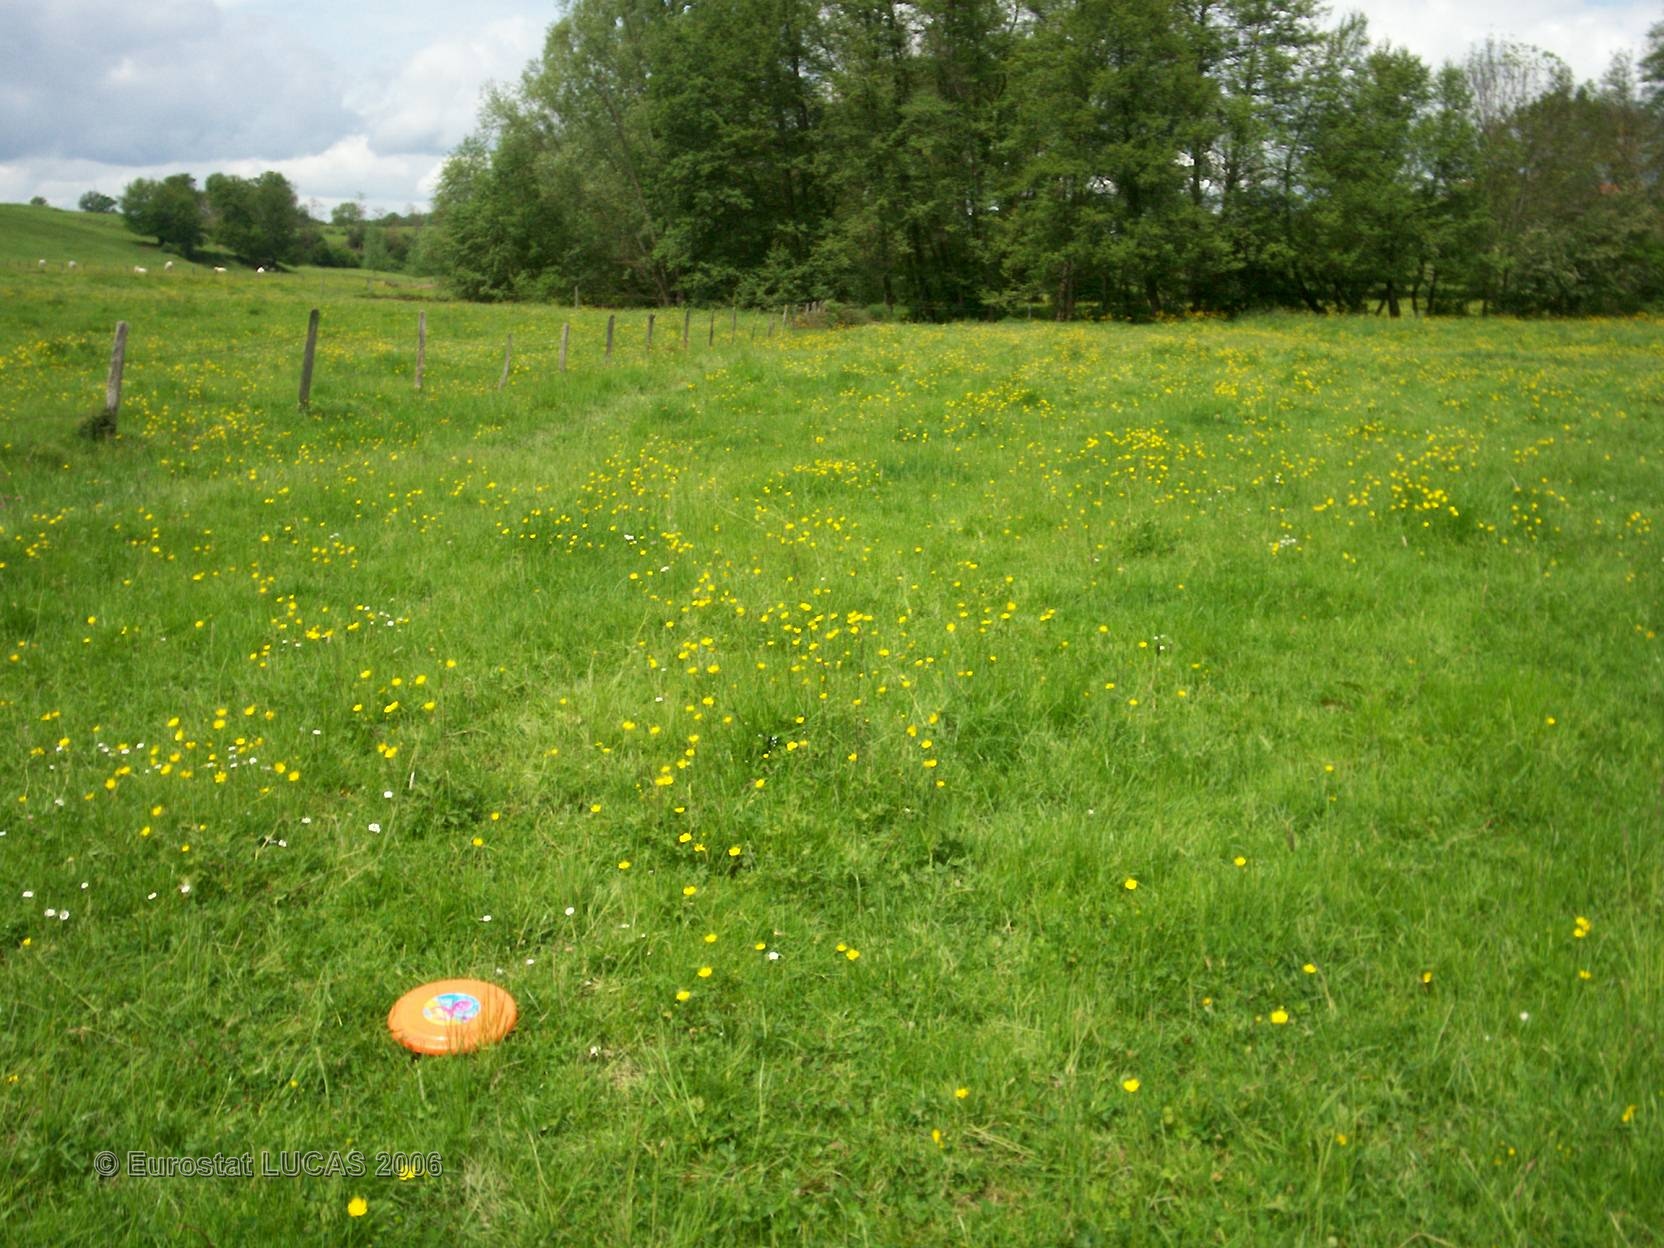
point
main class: Grassland
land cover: Grassland without tree/shrub cover
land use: Agriculture (excluding fallow land and kitchen gardens)
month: May
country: FR
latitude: 46.1183
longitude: 4.1397
